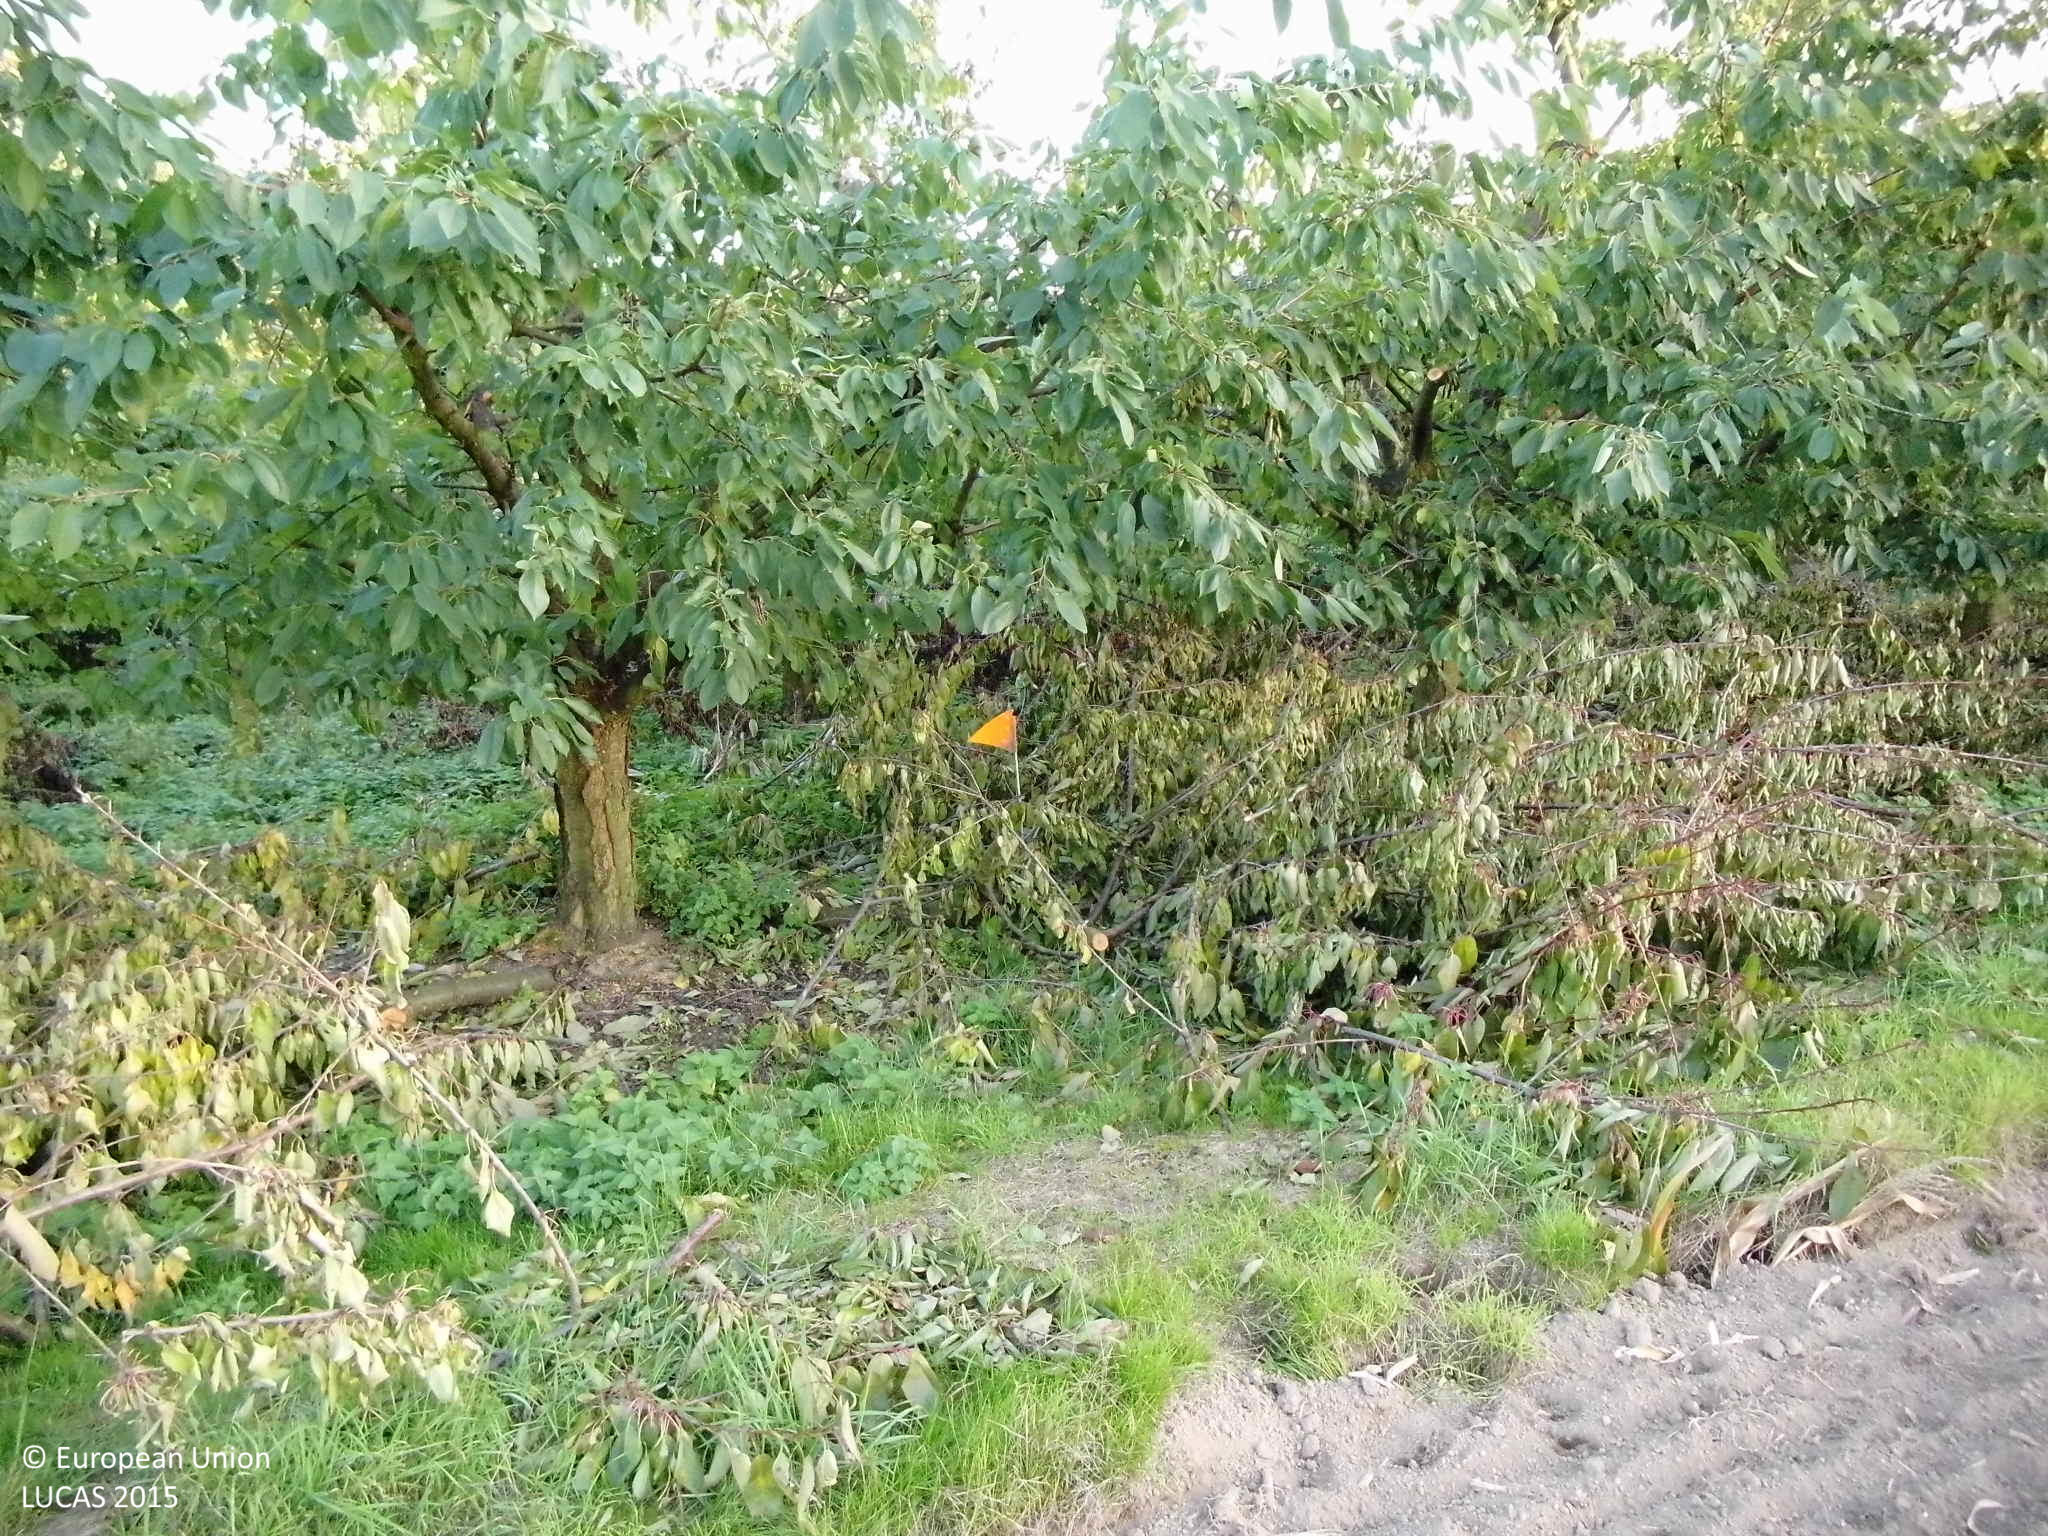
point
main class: Cropland
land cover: Cherry fruit
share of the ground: > 75 %
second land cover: Grassland without tree/shrub cover
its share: > 75 %
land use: Agriculture (excluding fallow land and kitchen gardens)
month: September
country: DE
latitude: 50.3897
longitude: 7.4544
